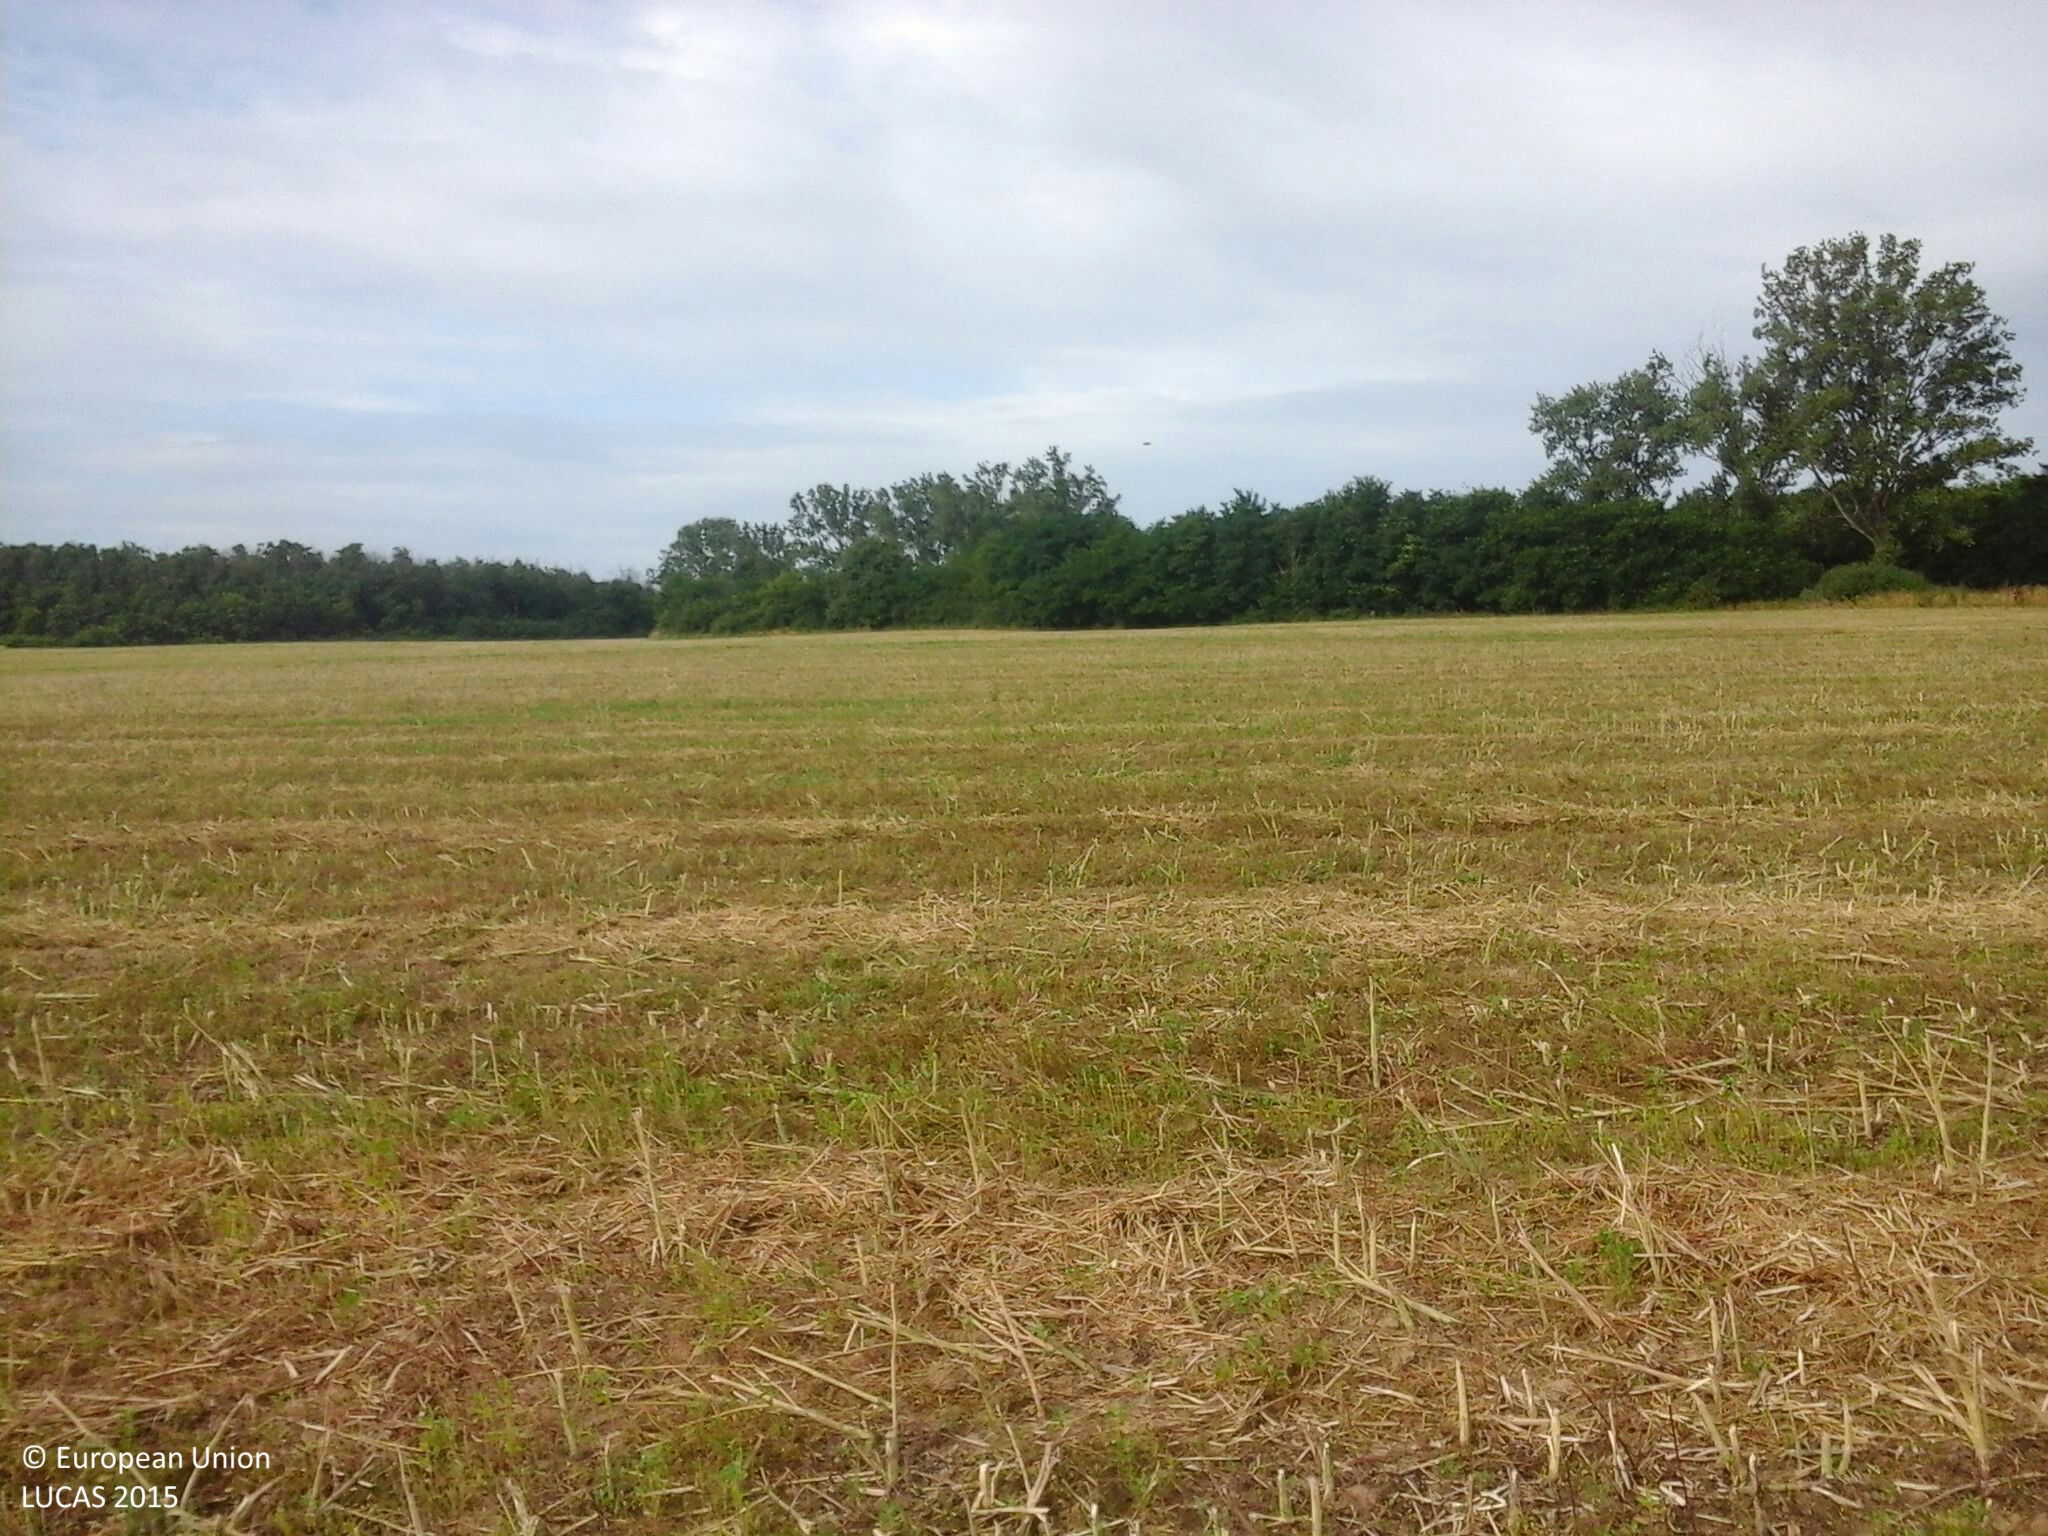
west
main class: Cropland
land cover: Rape and turnip rape
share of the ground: 10 - 25 %
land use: Agriculture (excluding fallow land and kitchen gardens)
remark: Harvested field
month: July
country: HU
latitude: 47.1860
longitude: 17.3041
